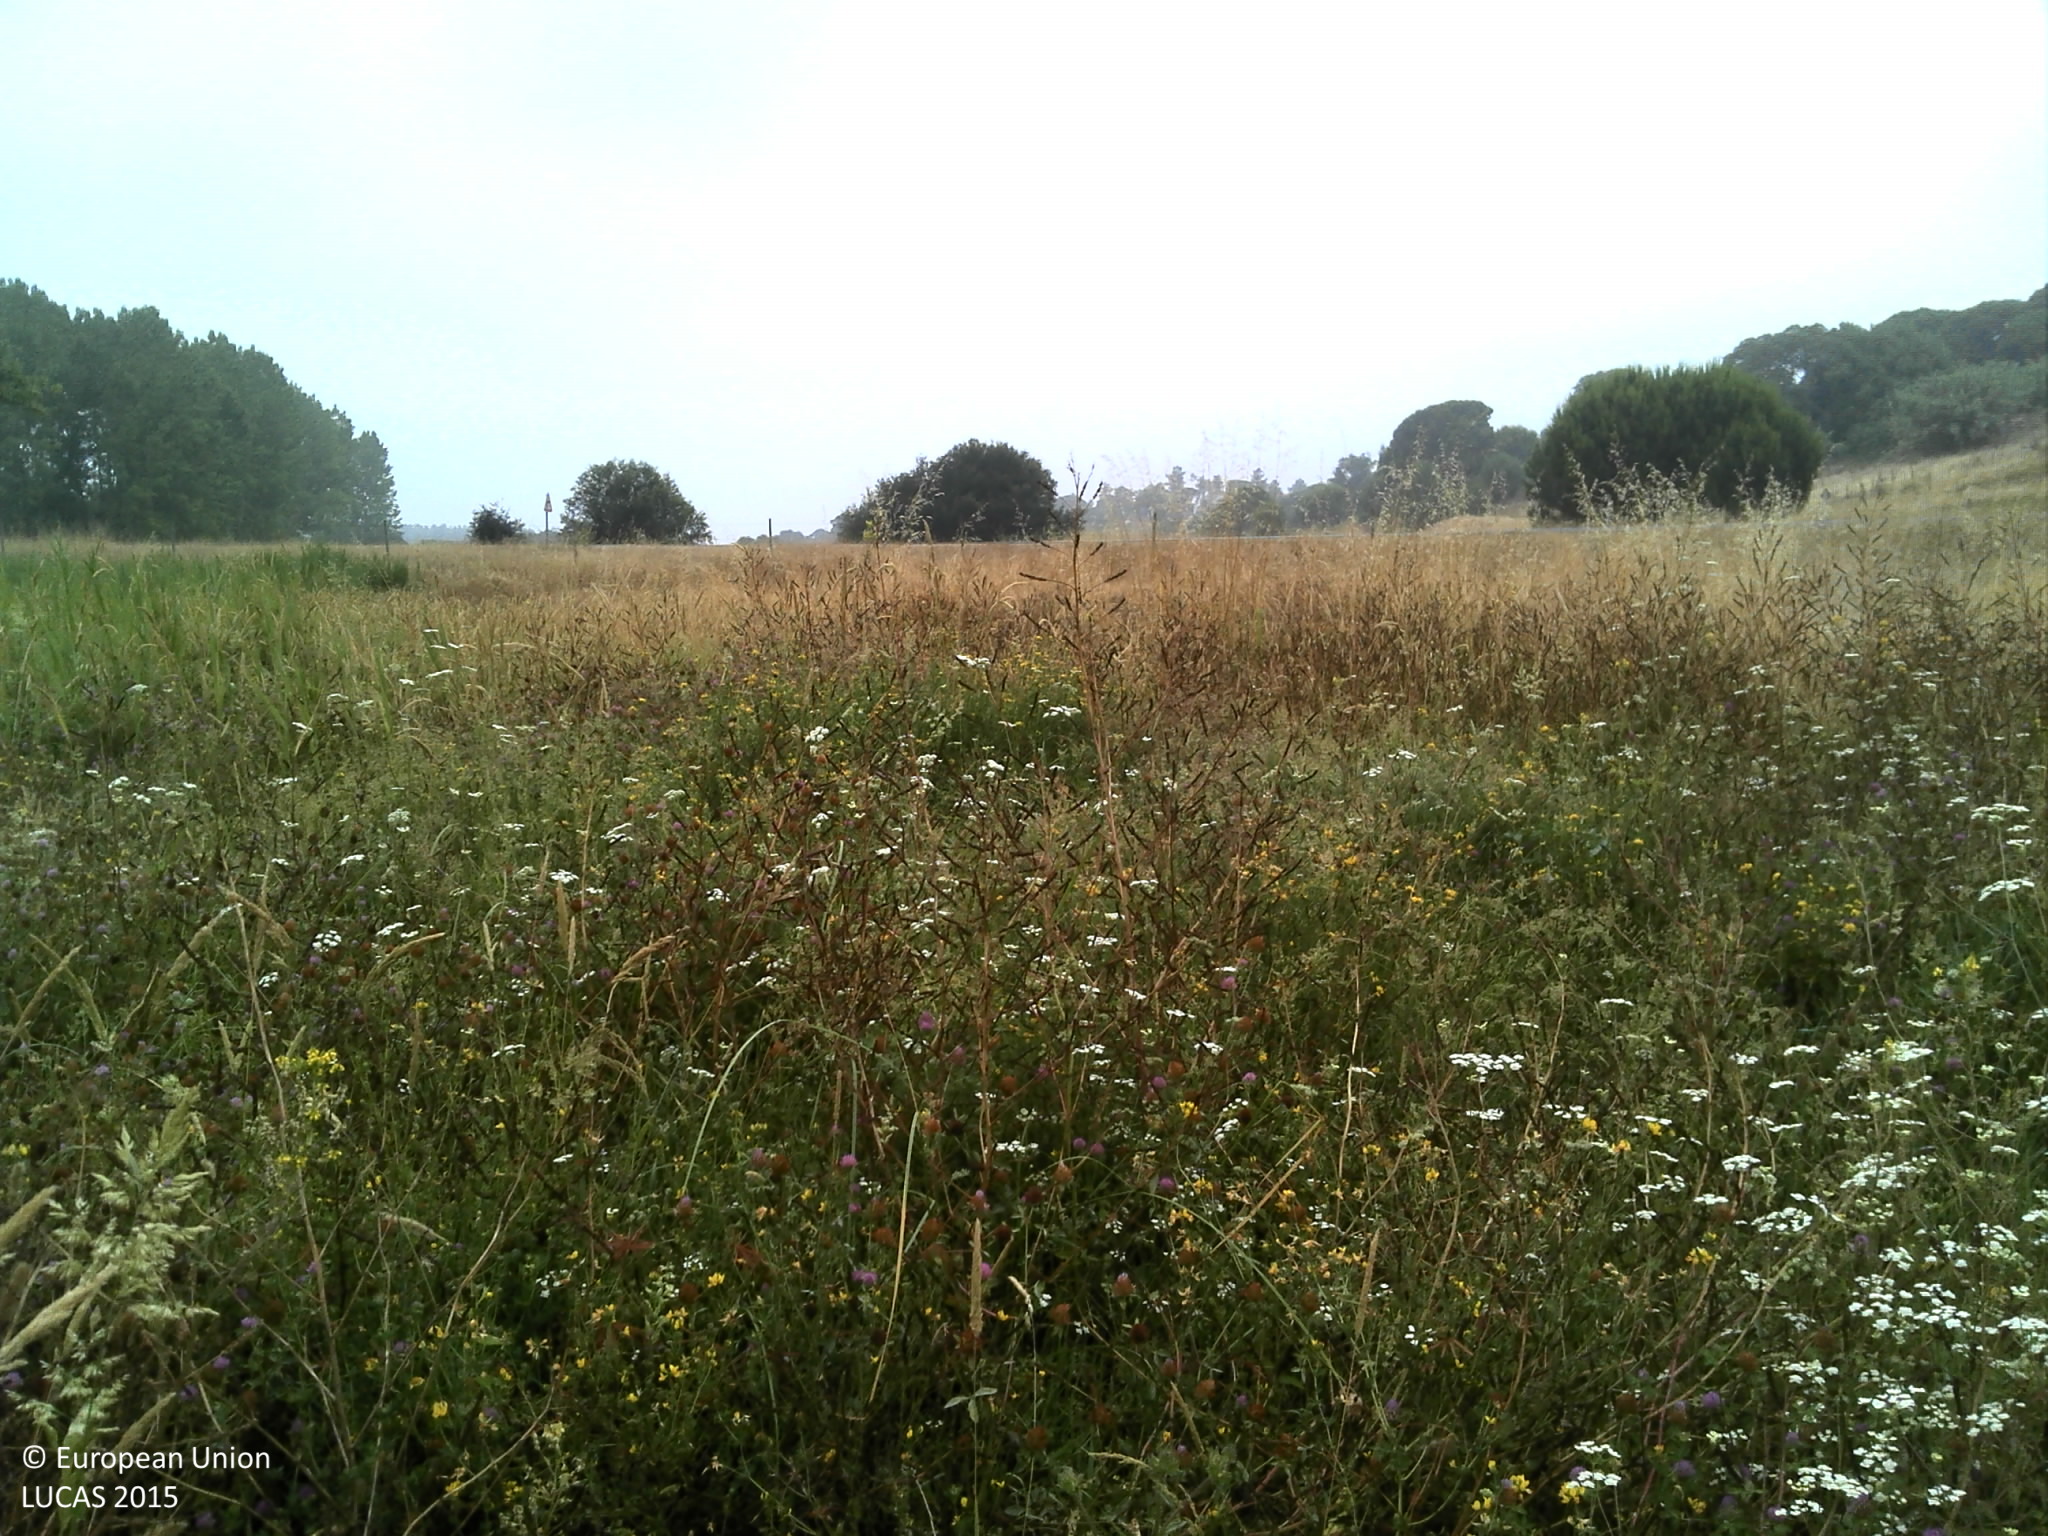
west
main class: Grassland
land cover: Spontaneously vegetated surfaces
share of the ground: > 75 %
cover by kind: herbaceous plants 95 %, unconsolidated bare surface 5 %
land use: Fallow land
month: June
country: PT
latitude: 38.5327
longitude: -9.1252
